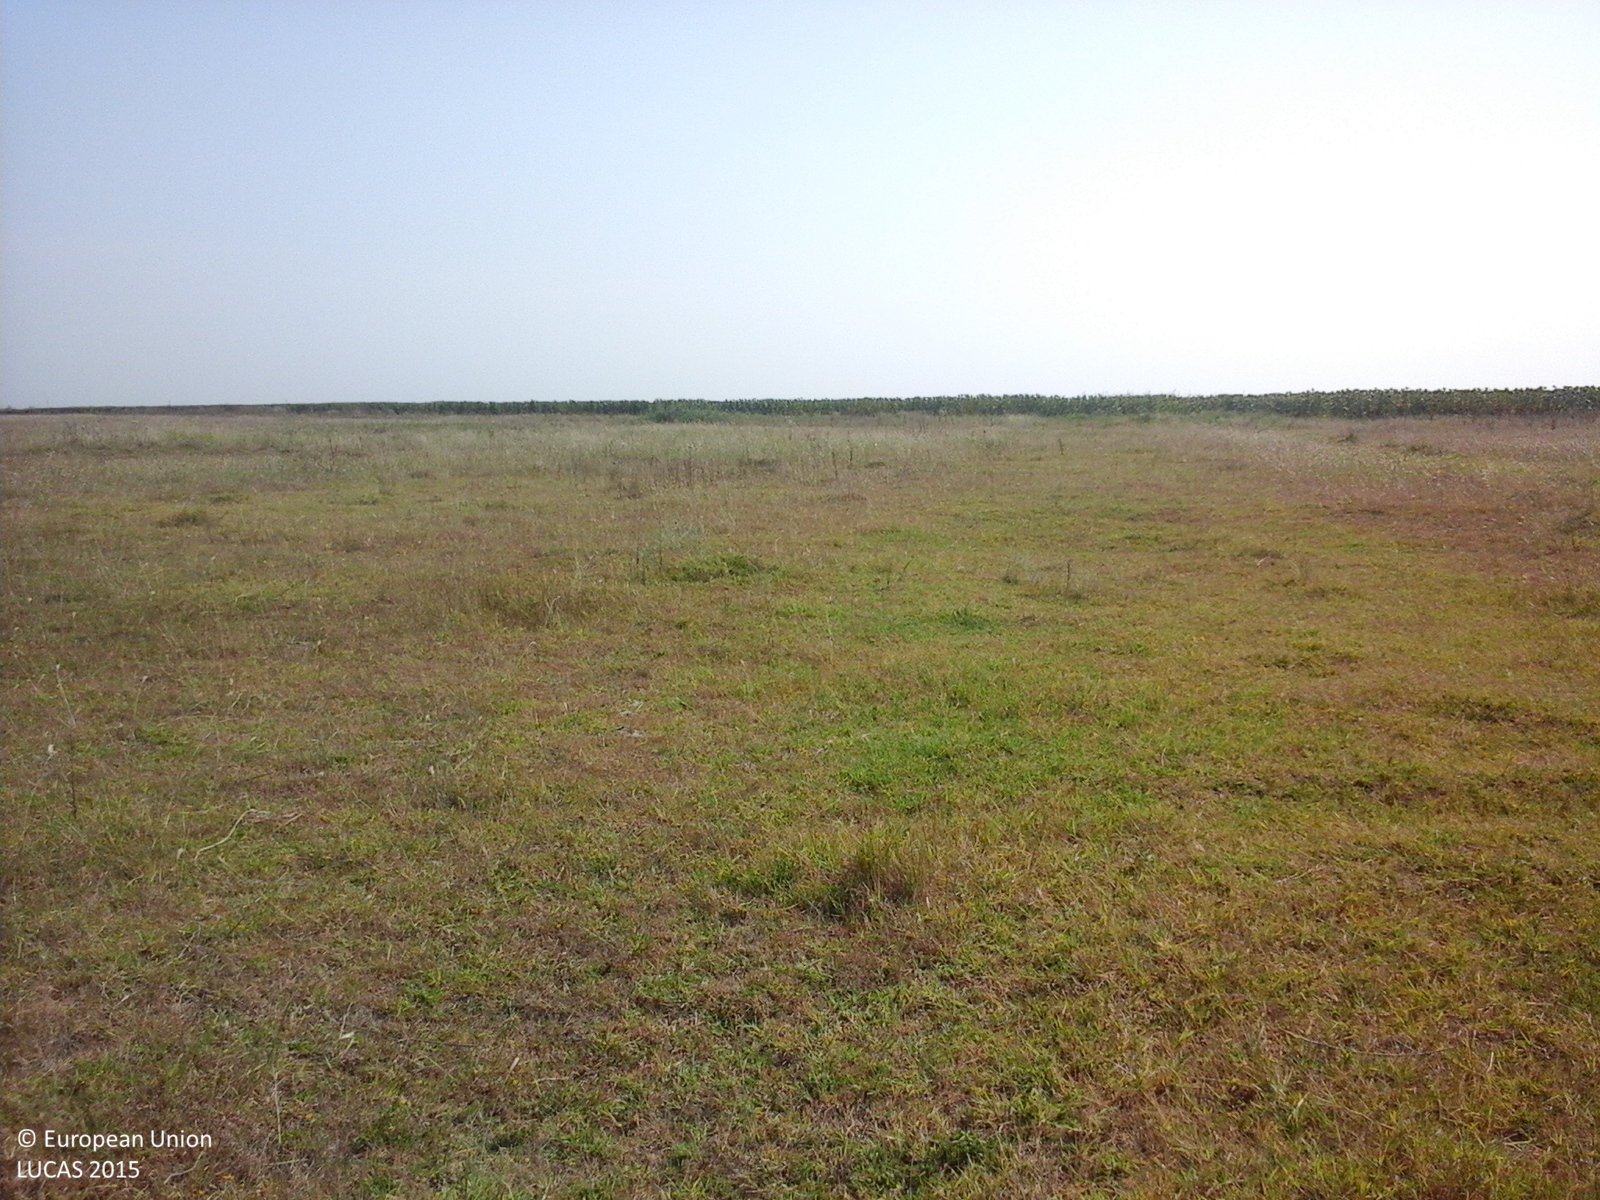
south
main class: Grassland
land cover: Grassland without tree/shrub cover
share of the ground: > 75 %
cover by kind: herbaceous plants 100 %
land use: Agriculture (excluding fallow land and kitchen gardens)
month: August
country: RO
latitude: 45.2074
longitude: 27.7142
